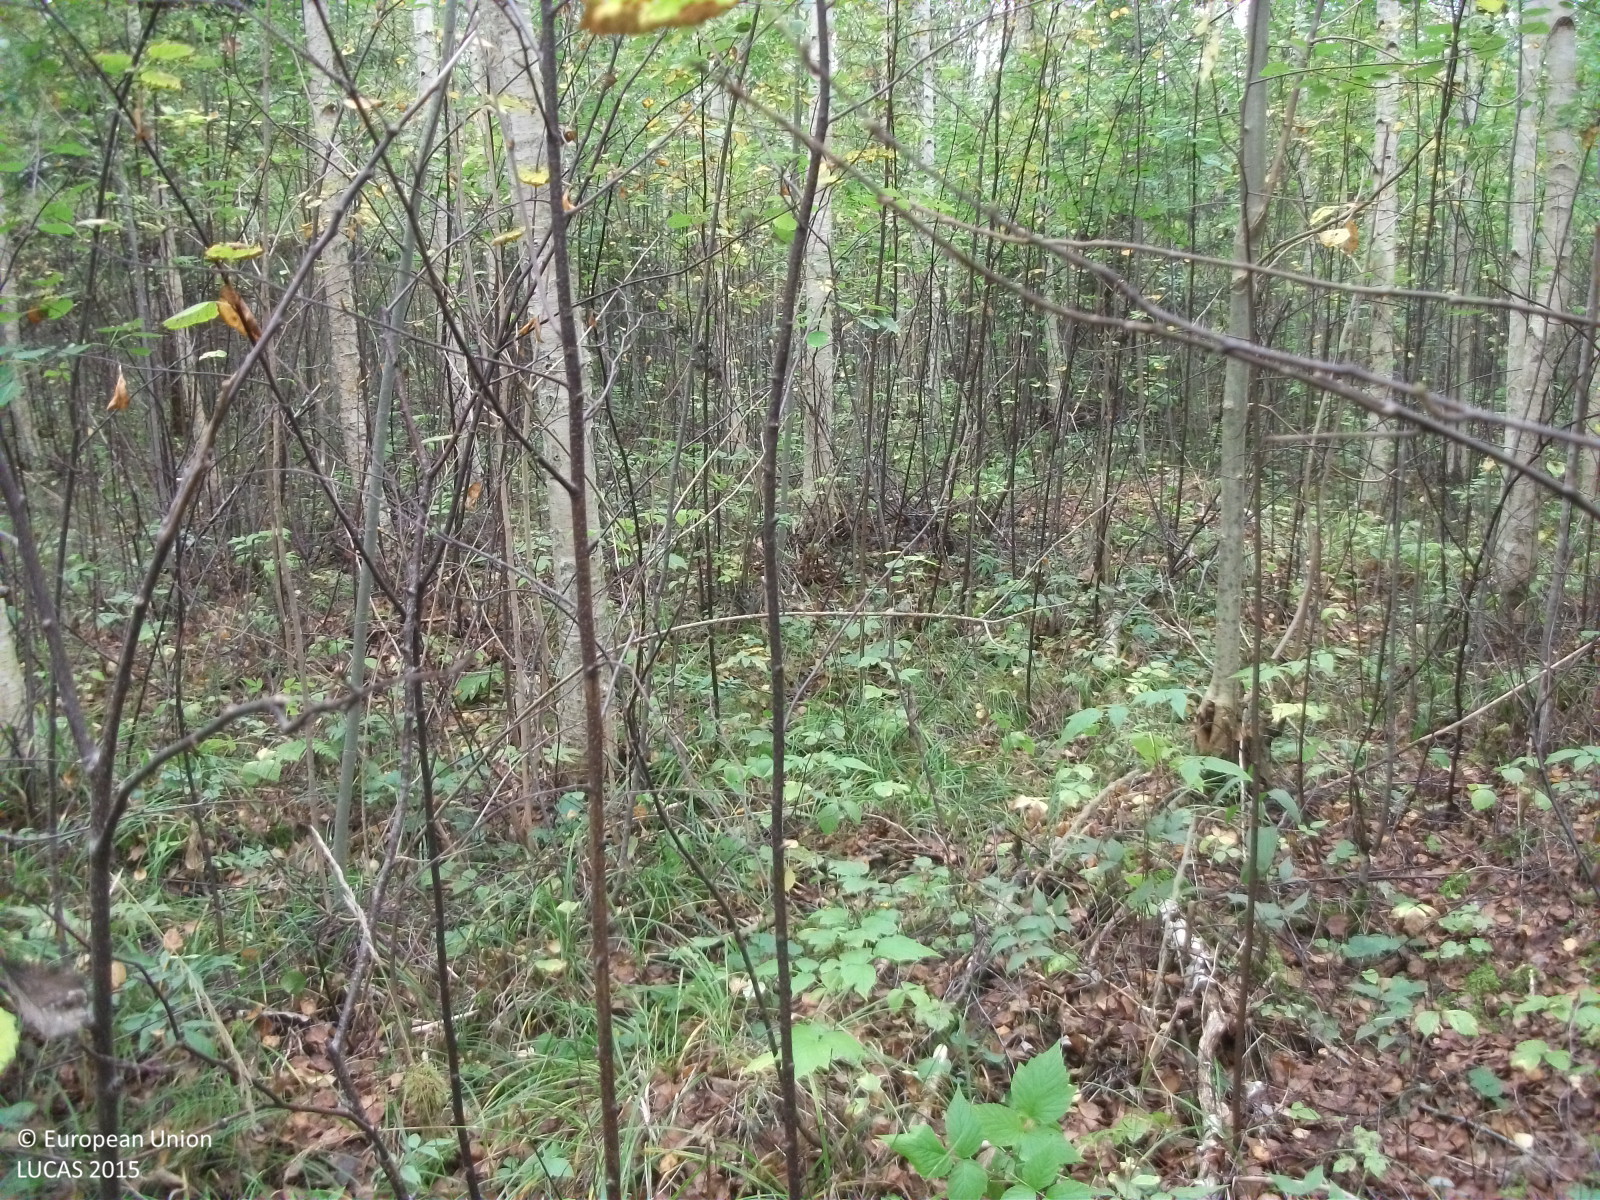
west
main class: Woodland
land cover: Broadleaved woodland
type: non-riverine alder, birch or aspen forest
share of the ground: > 75 %
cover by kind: broadleaved forest trees 90 %, shrubs 5 %, herbaceous plants 5 %
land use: Forestry
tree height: > 5 m
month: September
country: LV
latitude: 57.8074
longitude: 24.3743
